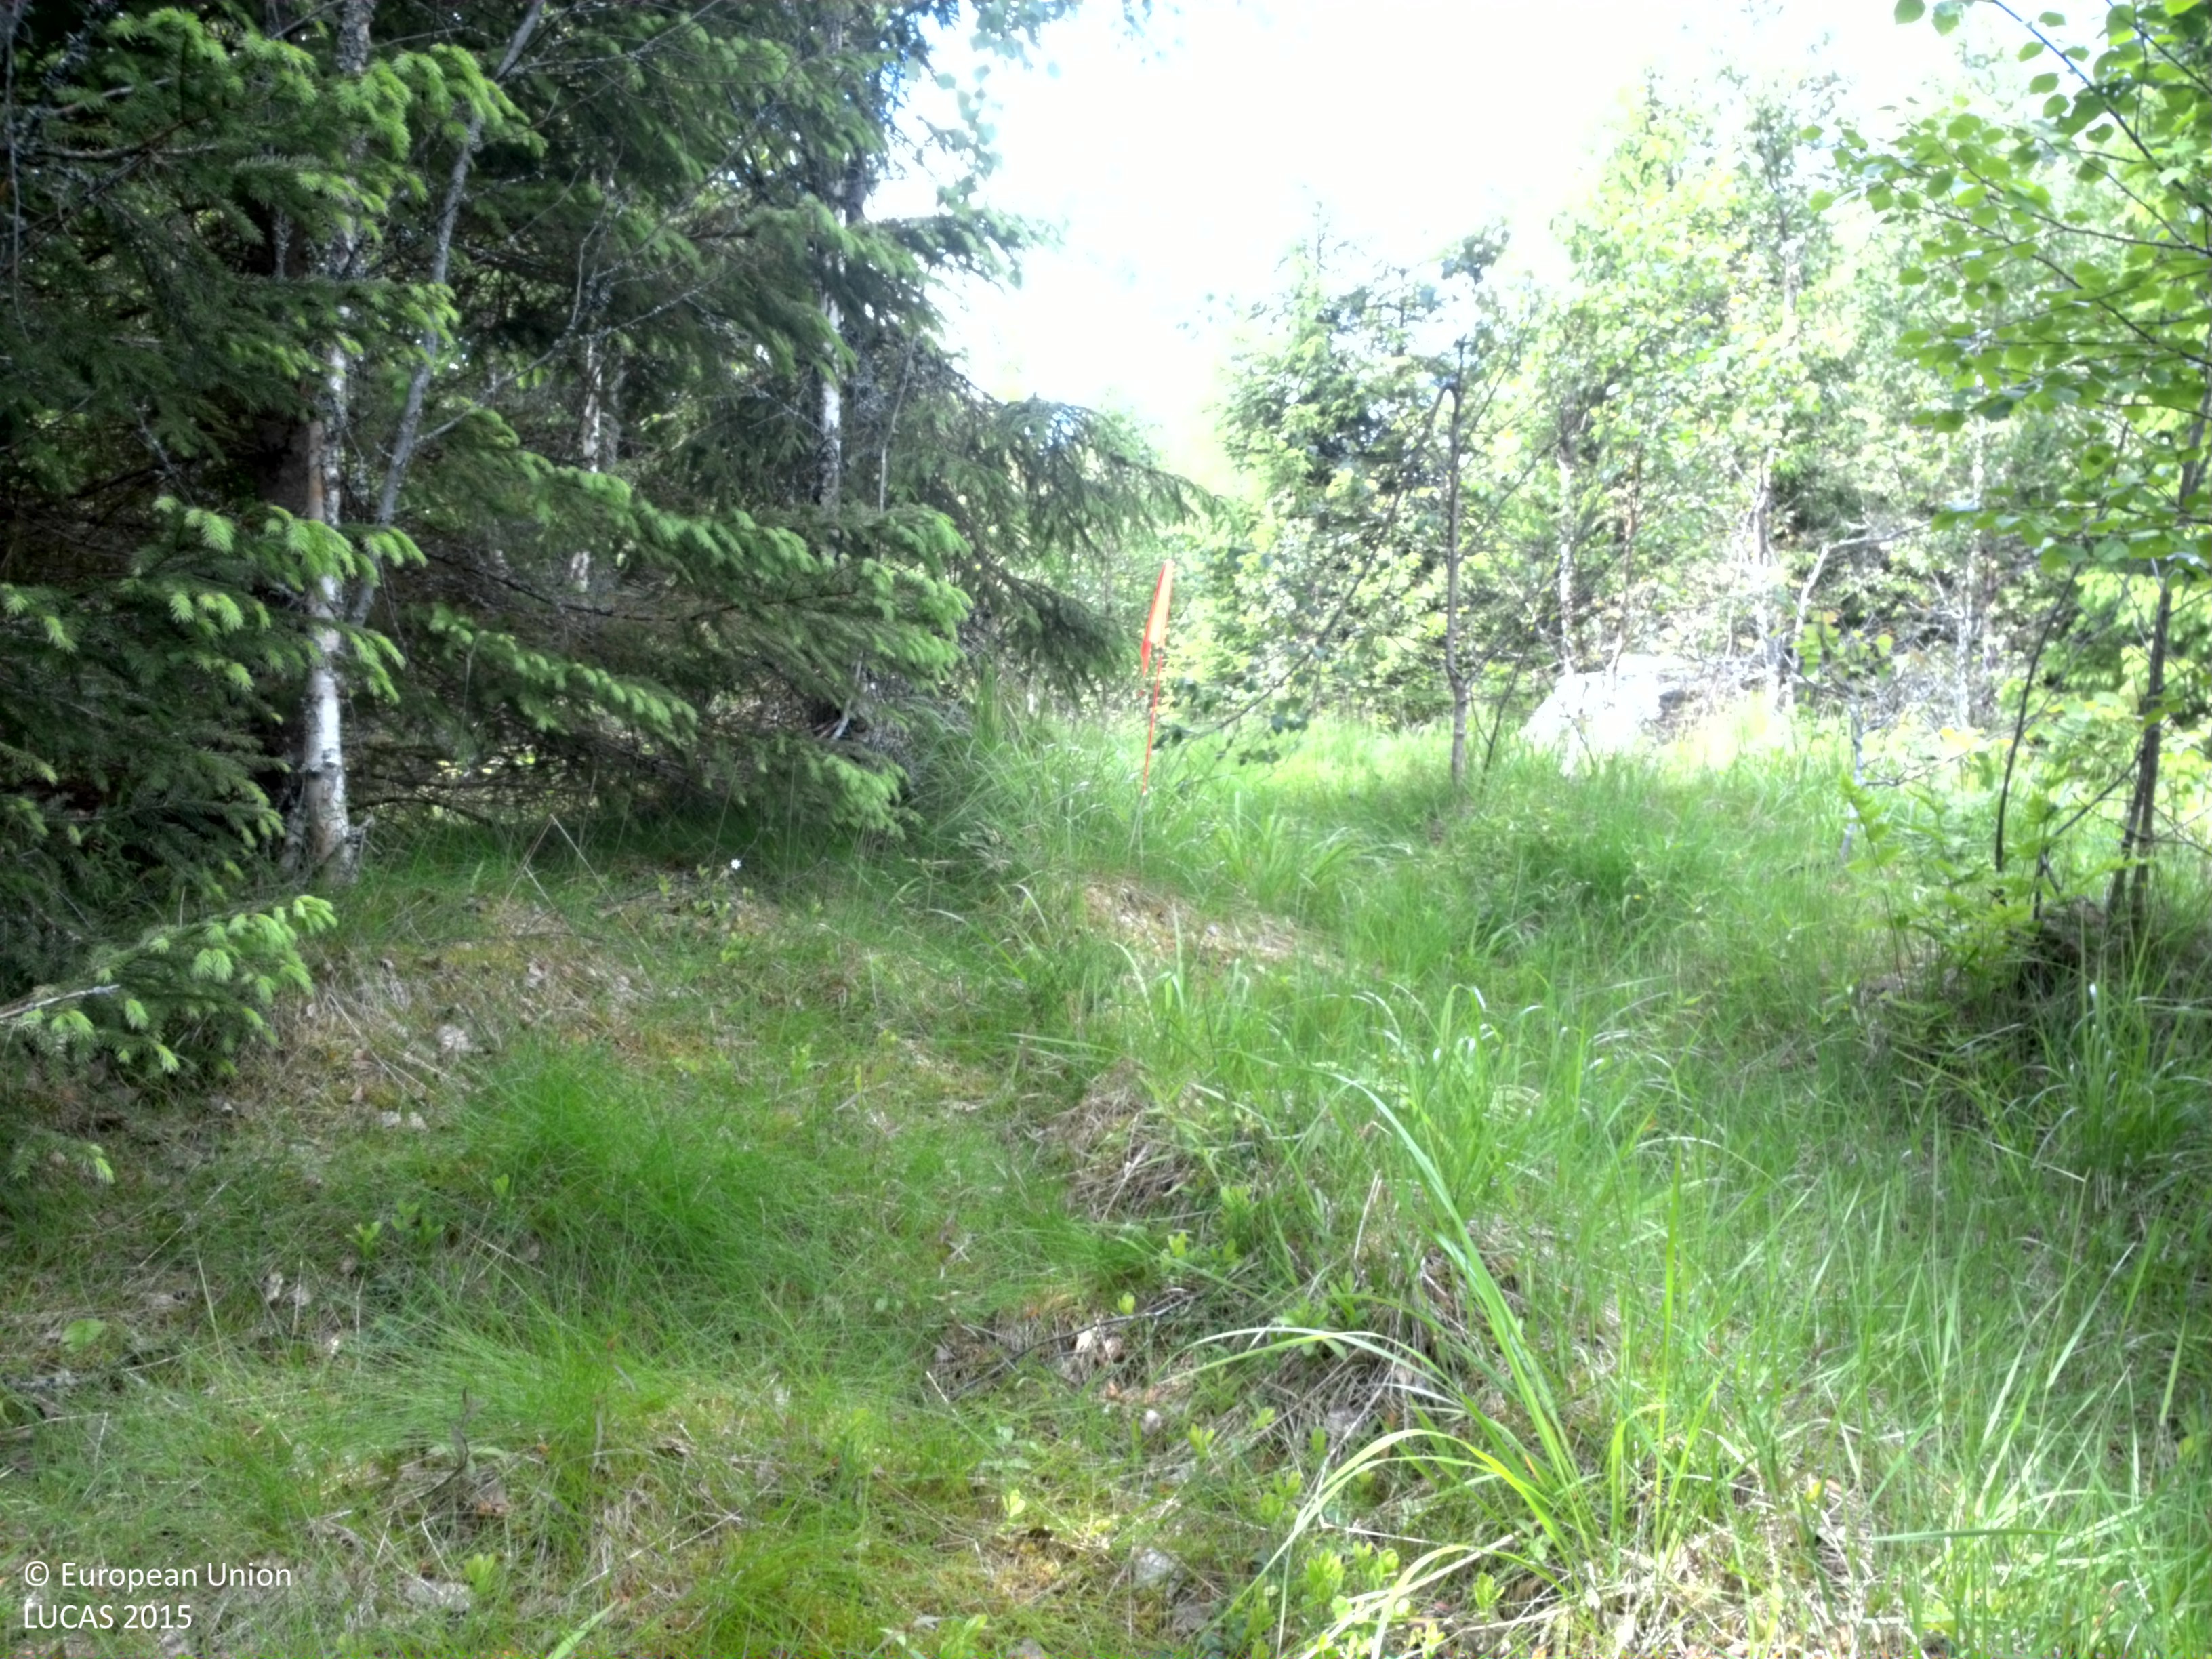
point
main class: Woodland
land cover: Spruce dominated mixed woodland
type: boreal forest
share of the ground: 25 - 50 %
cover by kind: herbaceous plants 40 %, coniferous forest trees 35 %, broadleaved forest trees 15 %, shrubs 5 %, lichens and mosses 5 %
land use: Forestry
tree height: > 5 m
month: June
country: SE
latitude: 59.9691
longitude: 17.0319
